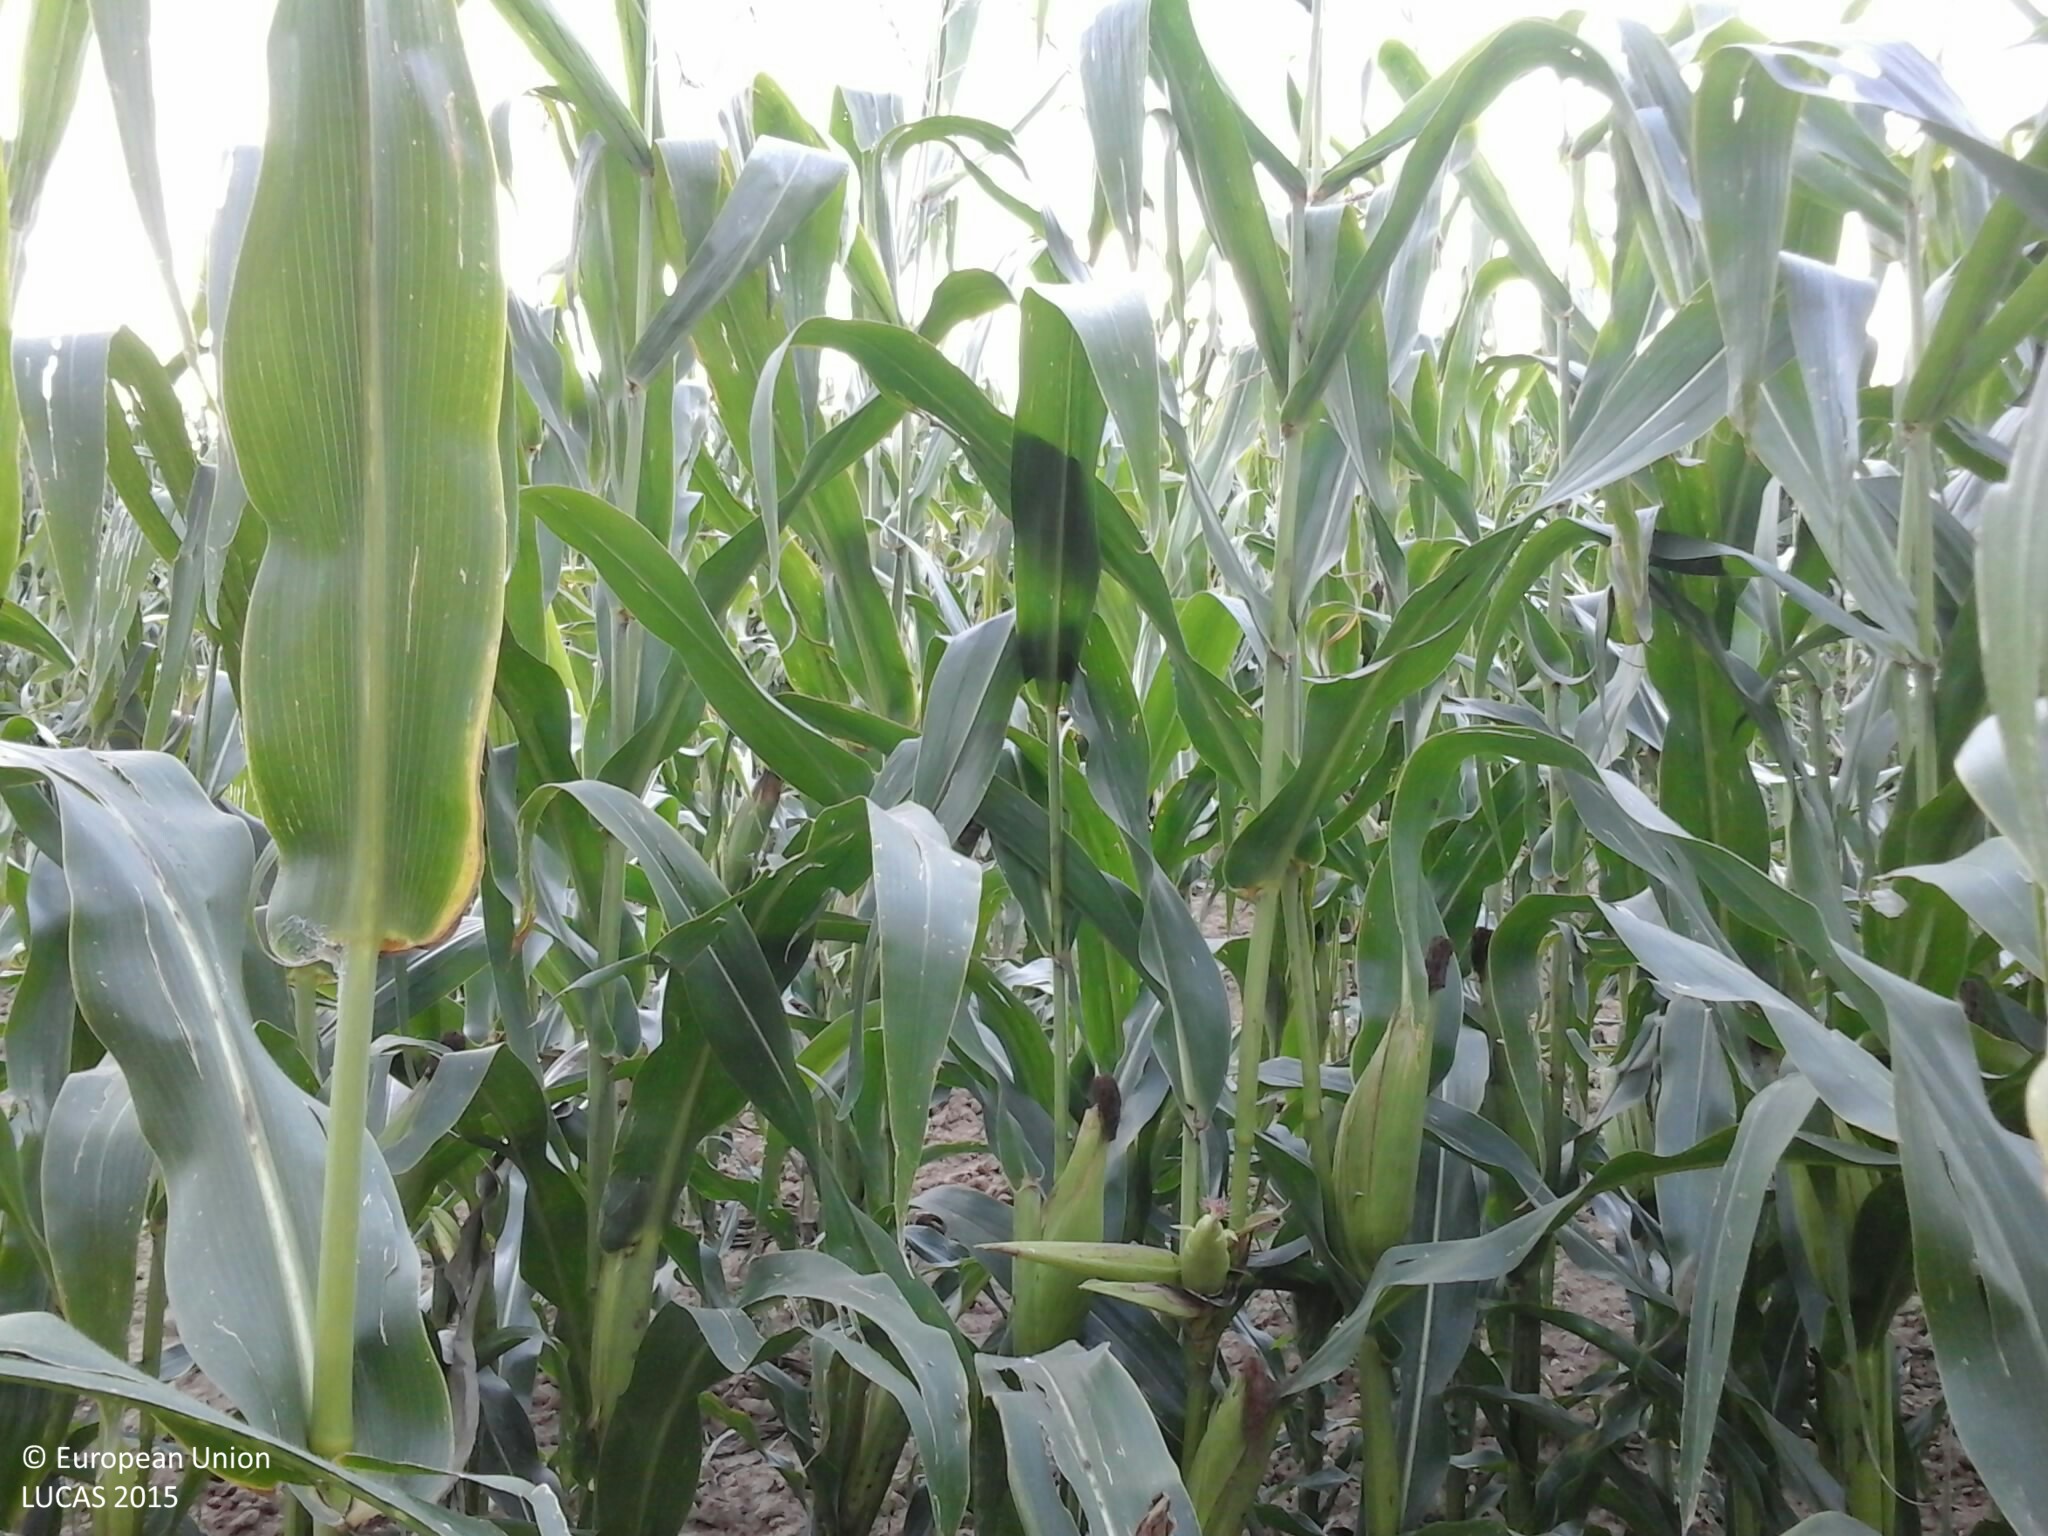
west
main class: Cropland
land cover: Maize
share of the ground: > 75 %
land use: Agriculture (excluding fallow land and kitchen gardens)
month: August
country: HU
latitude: 45.9734
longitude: 18.3059
